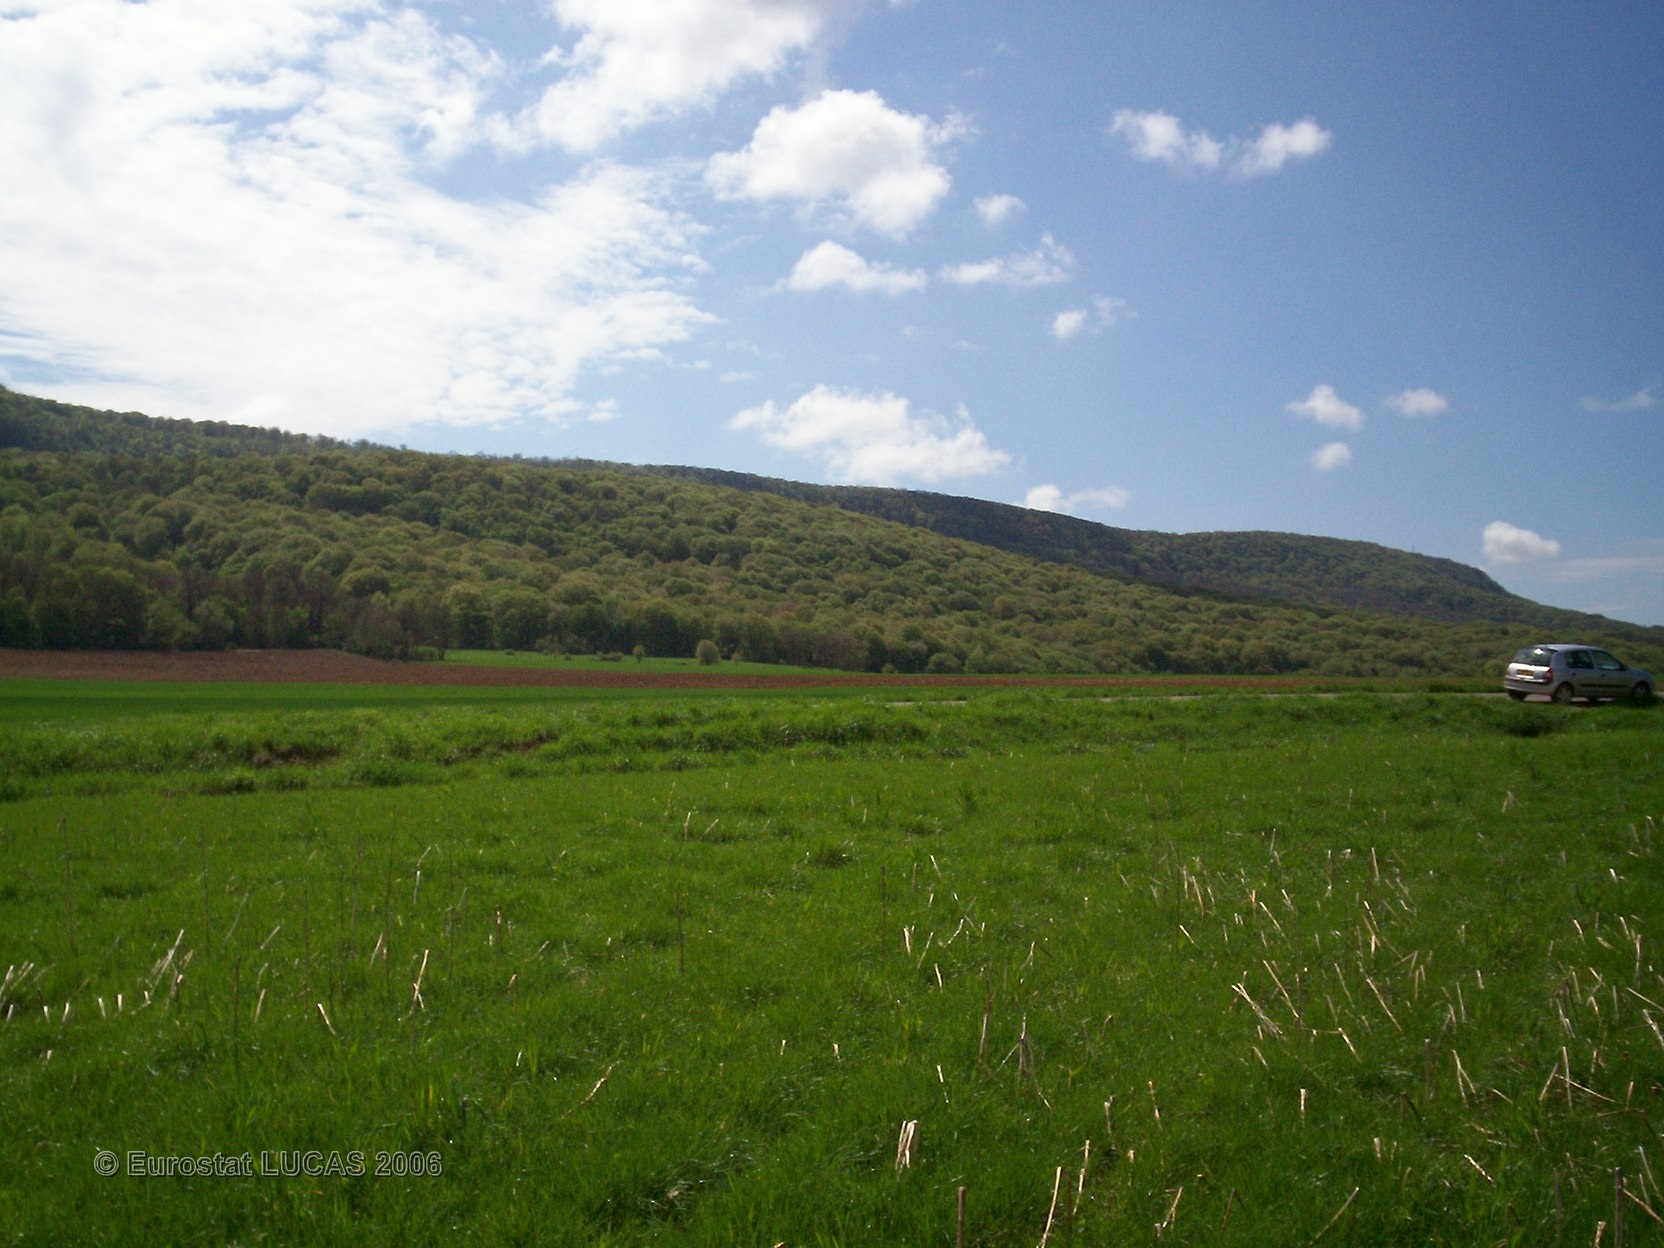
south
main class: Grassland
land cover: Grassland without tree/shrub cover
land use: Fallow land
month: April
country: FR
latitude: 47.3436
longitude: 6.0970
